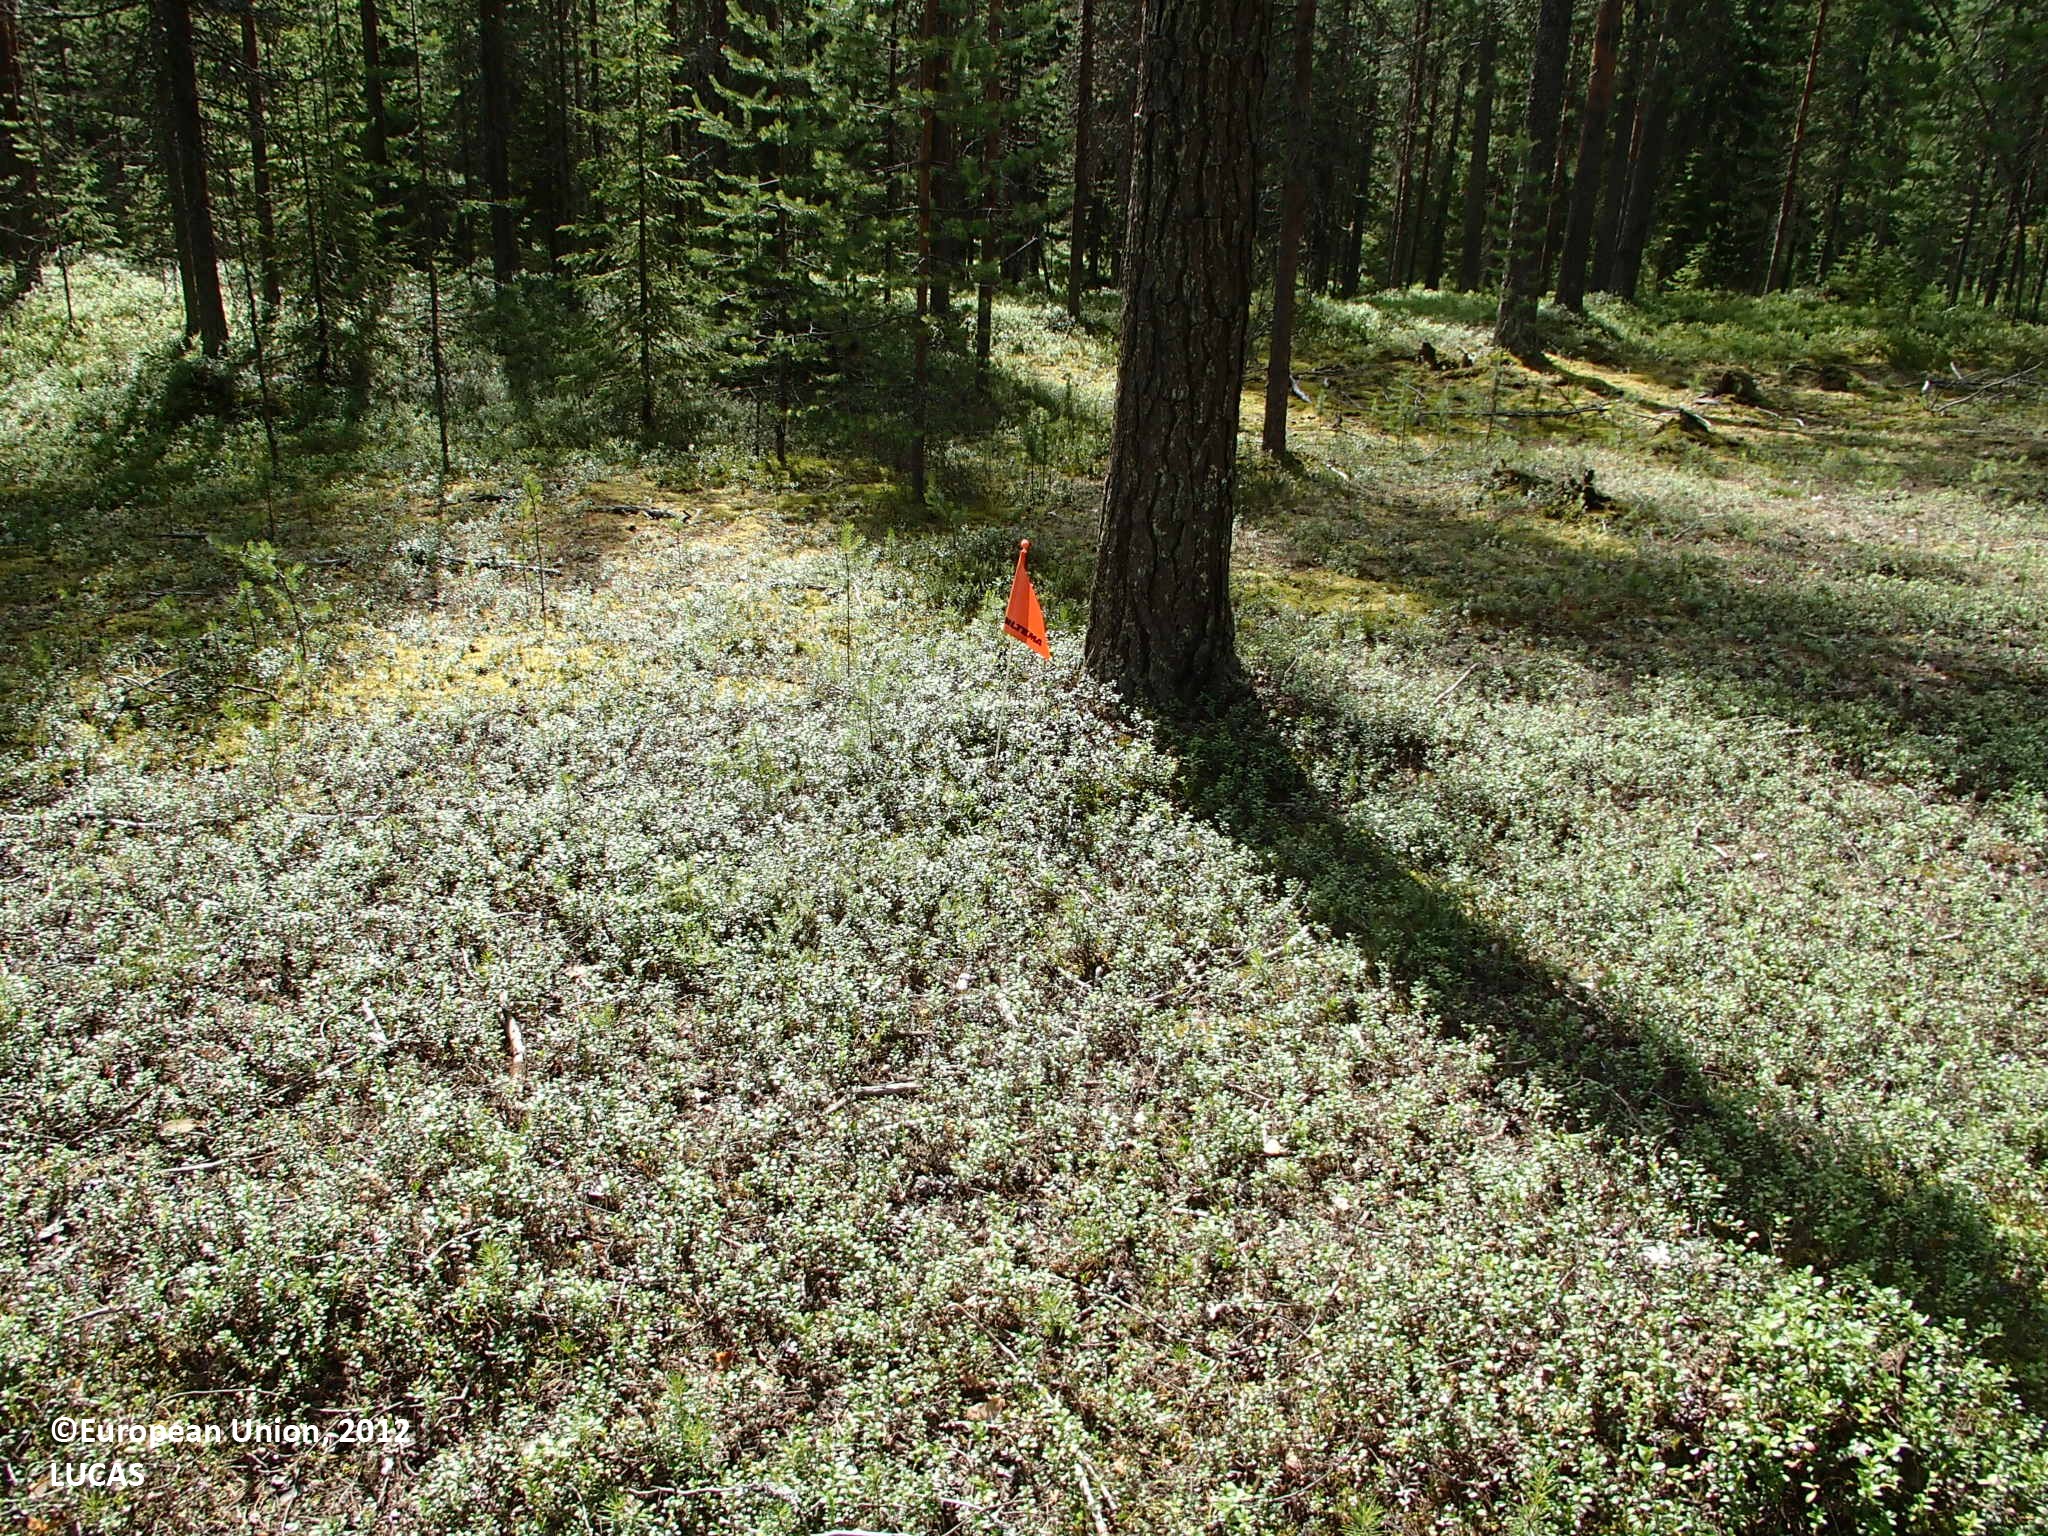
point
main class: Woodland
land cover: Pine dominated coniferous woodland
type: boreal forest
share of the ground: > 75 %
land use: Forestry
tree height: > 5 m
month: July
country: FI
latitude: 66.4071
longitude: 25.4922
